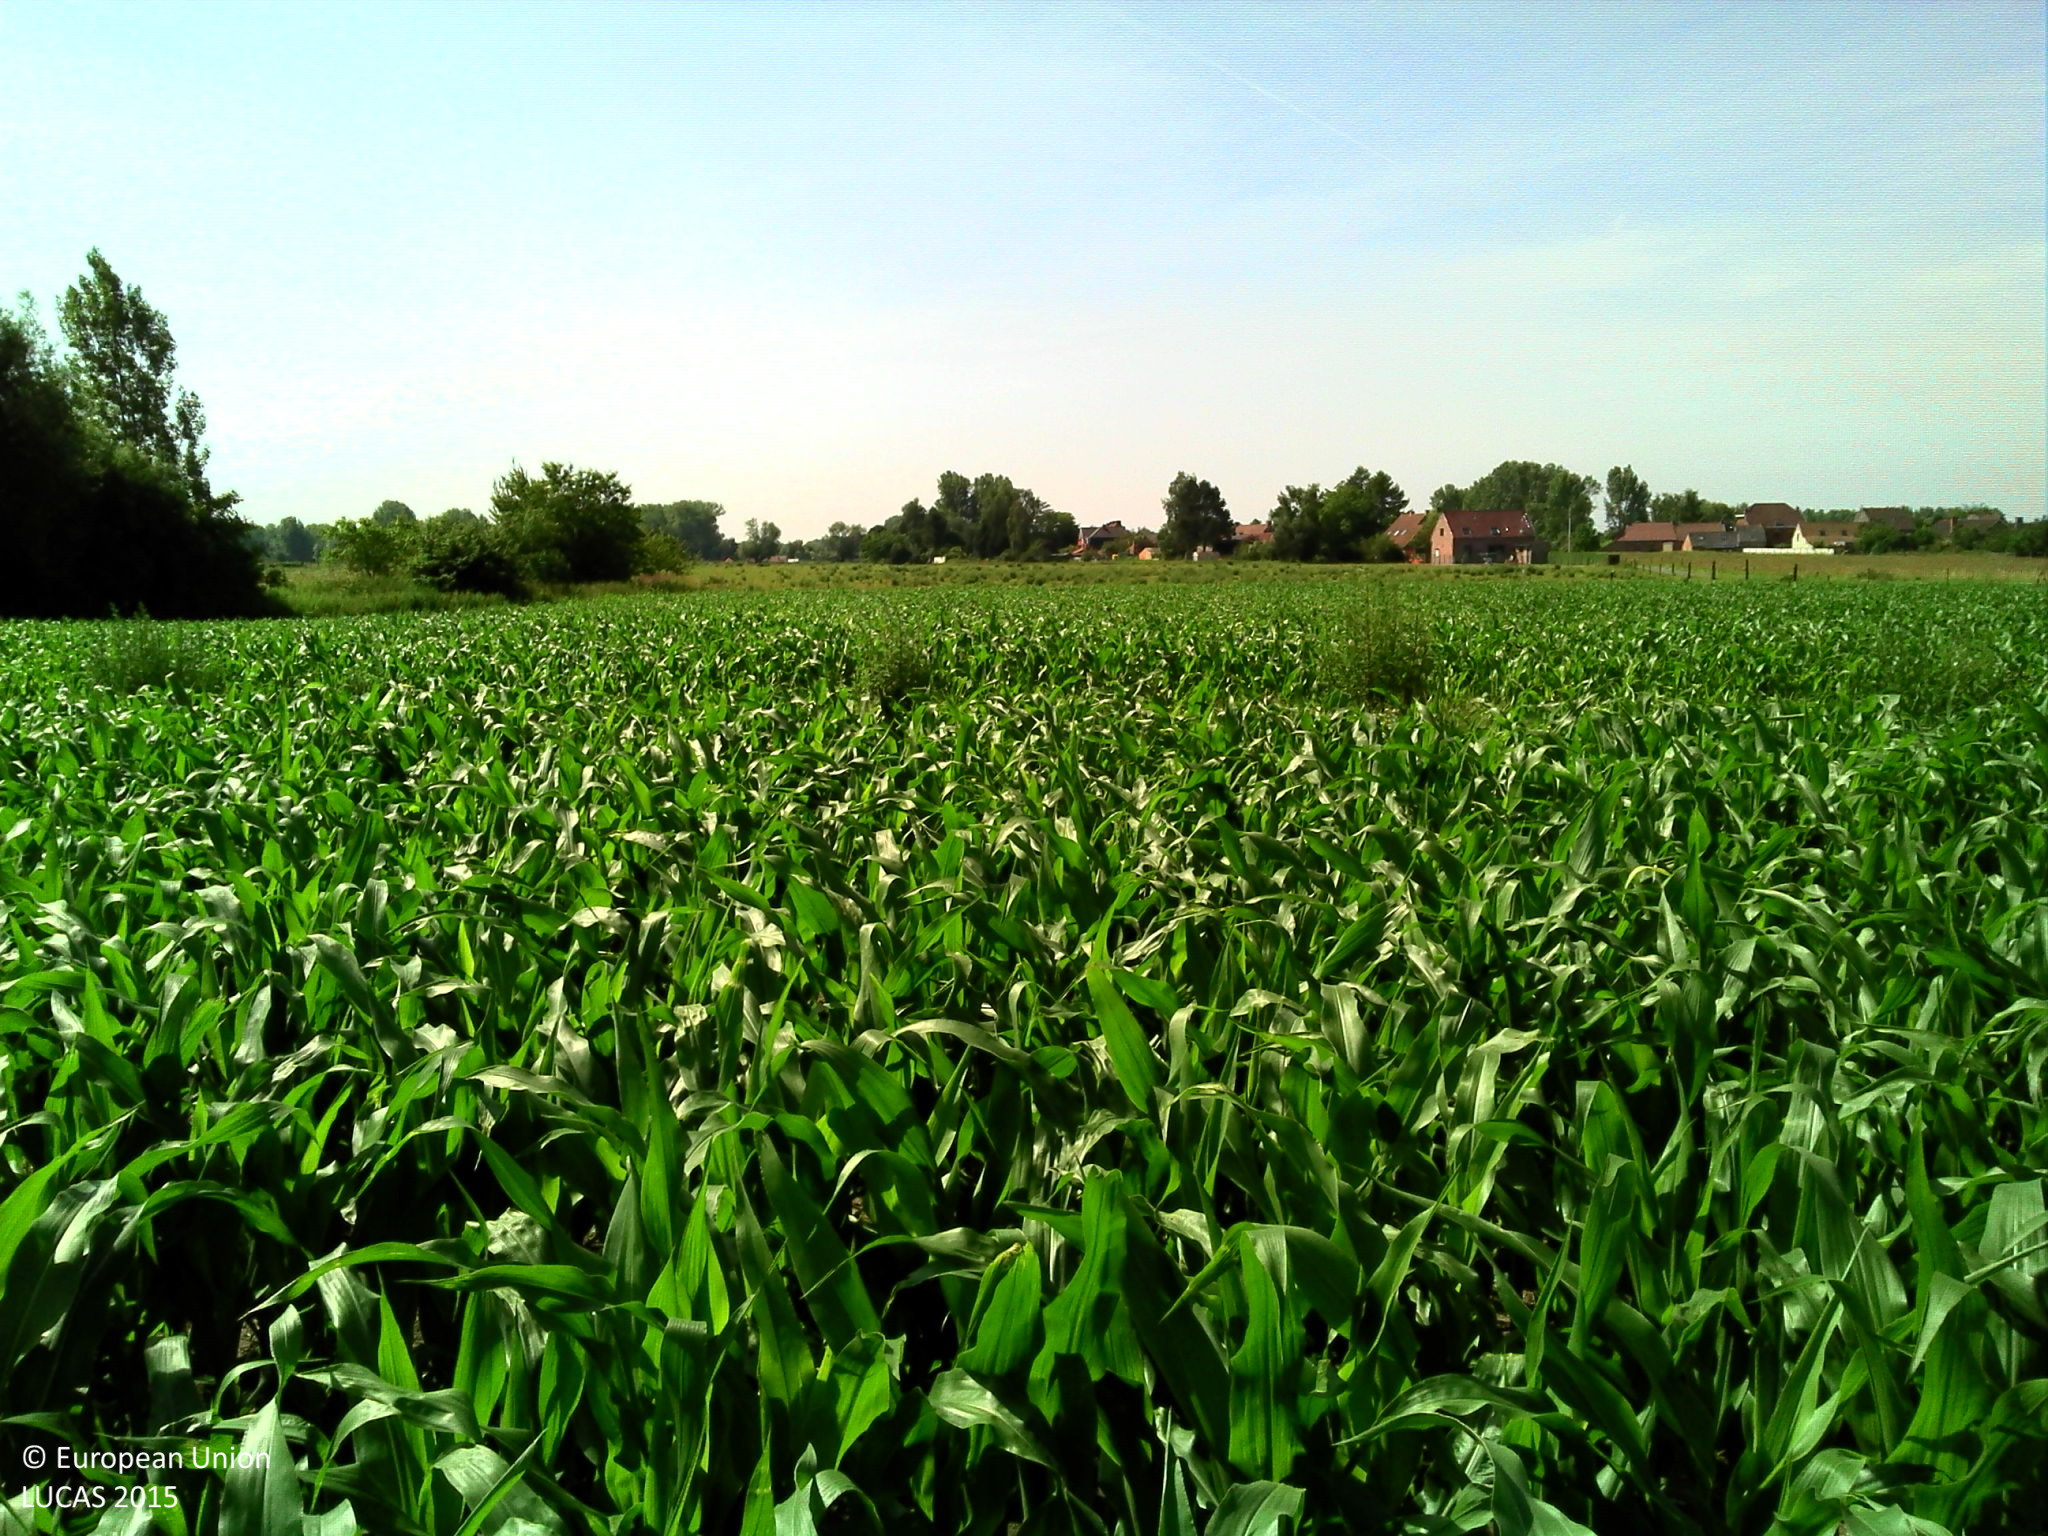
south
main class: Cropland
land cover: Maize
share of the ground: 50 - 75 %
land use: Agriculture (excluding fallow land and kitchen gardens)
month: June
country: BE
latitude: 50.5066
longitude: 3.5487
